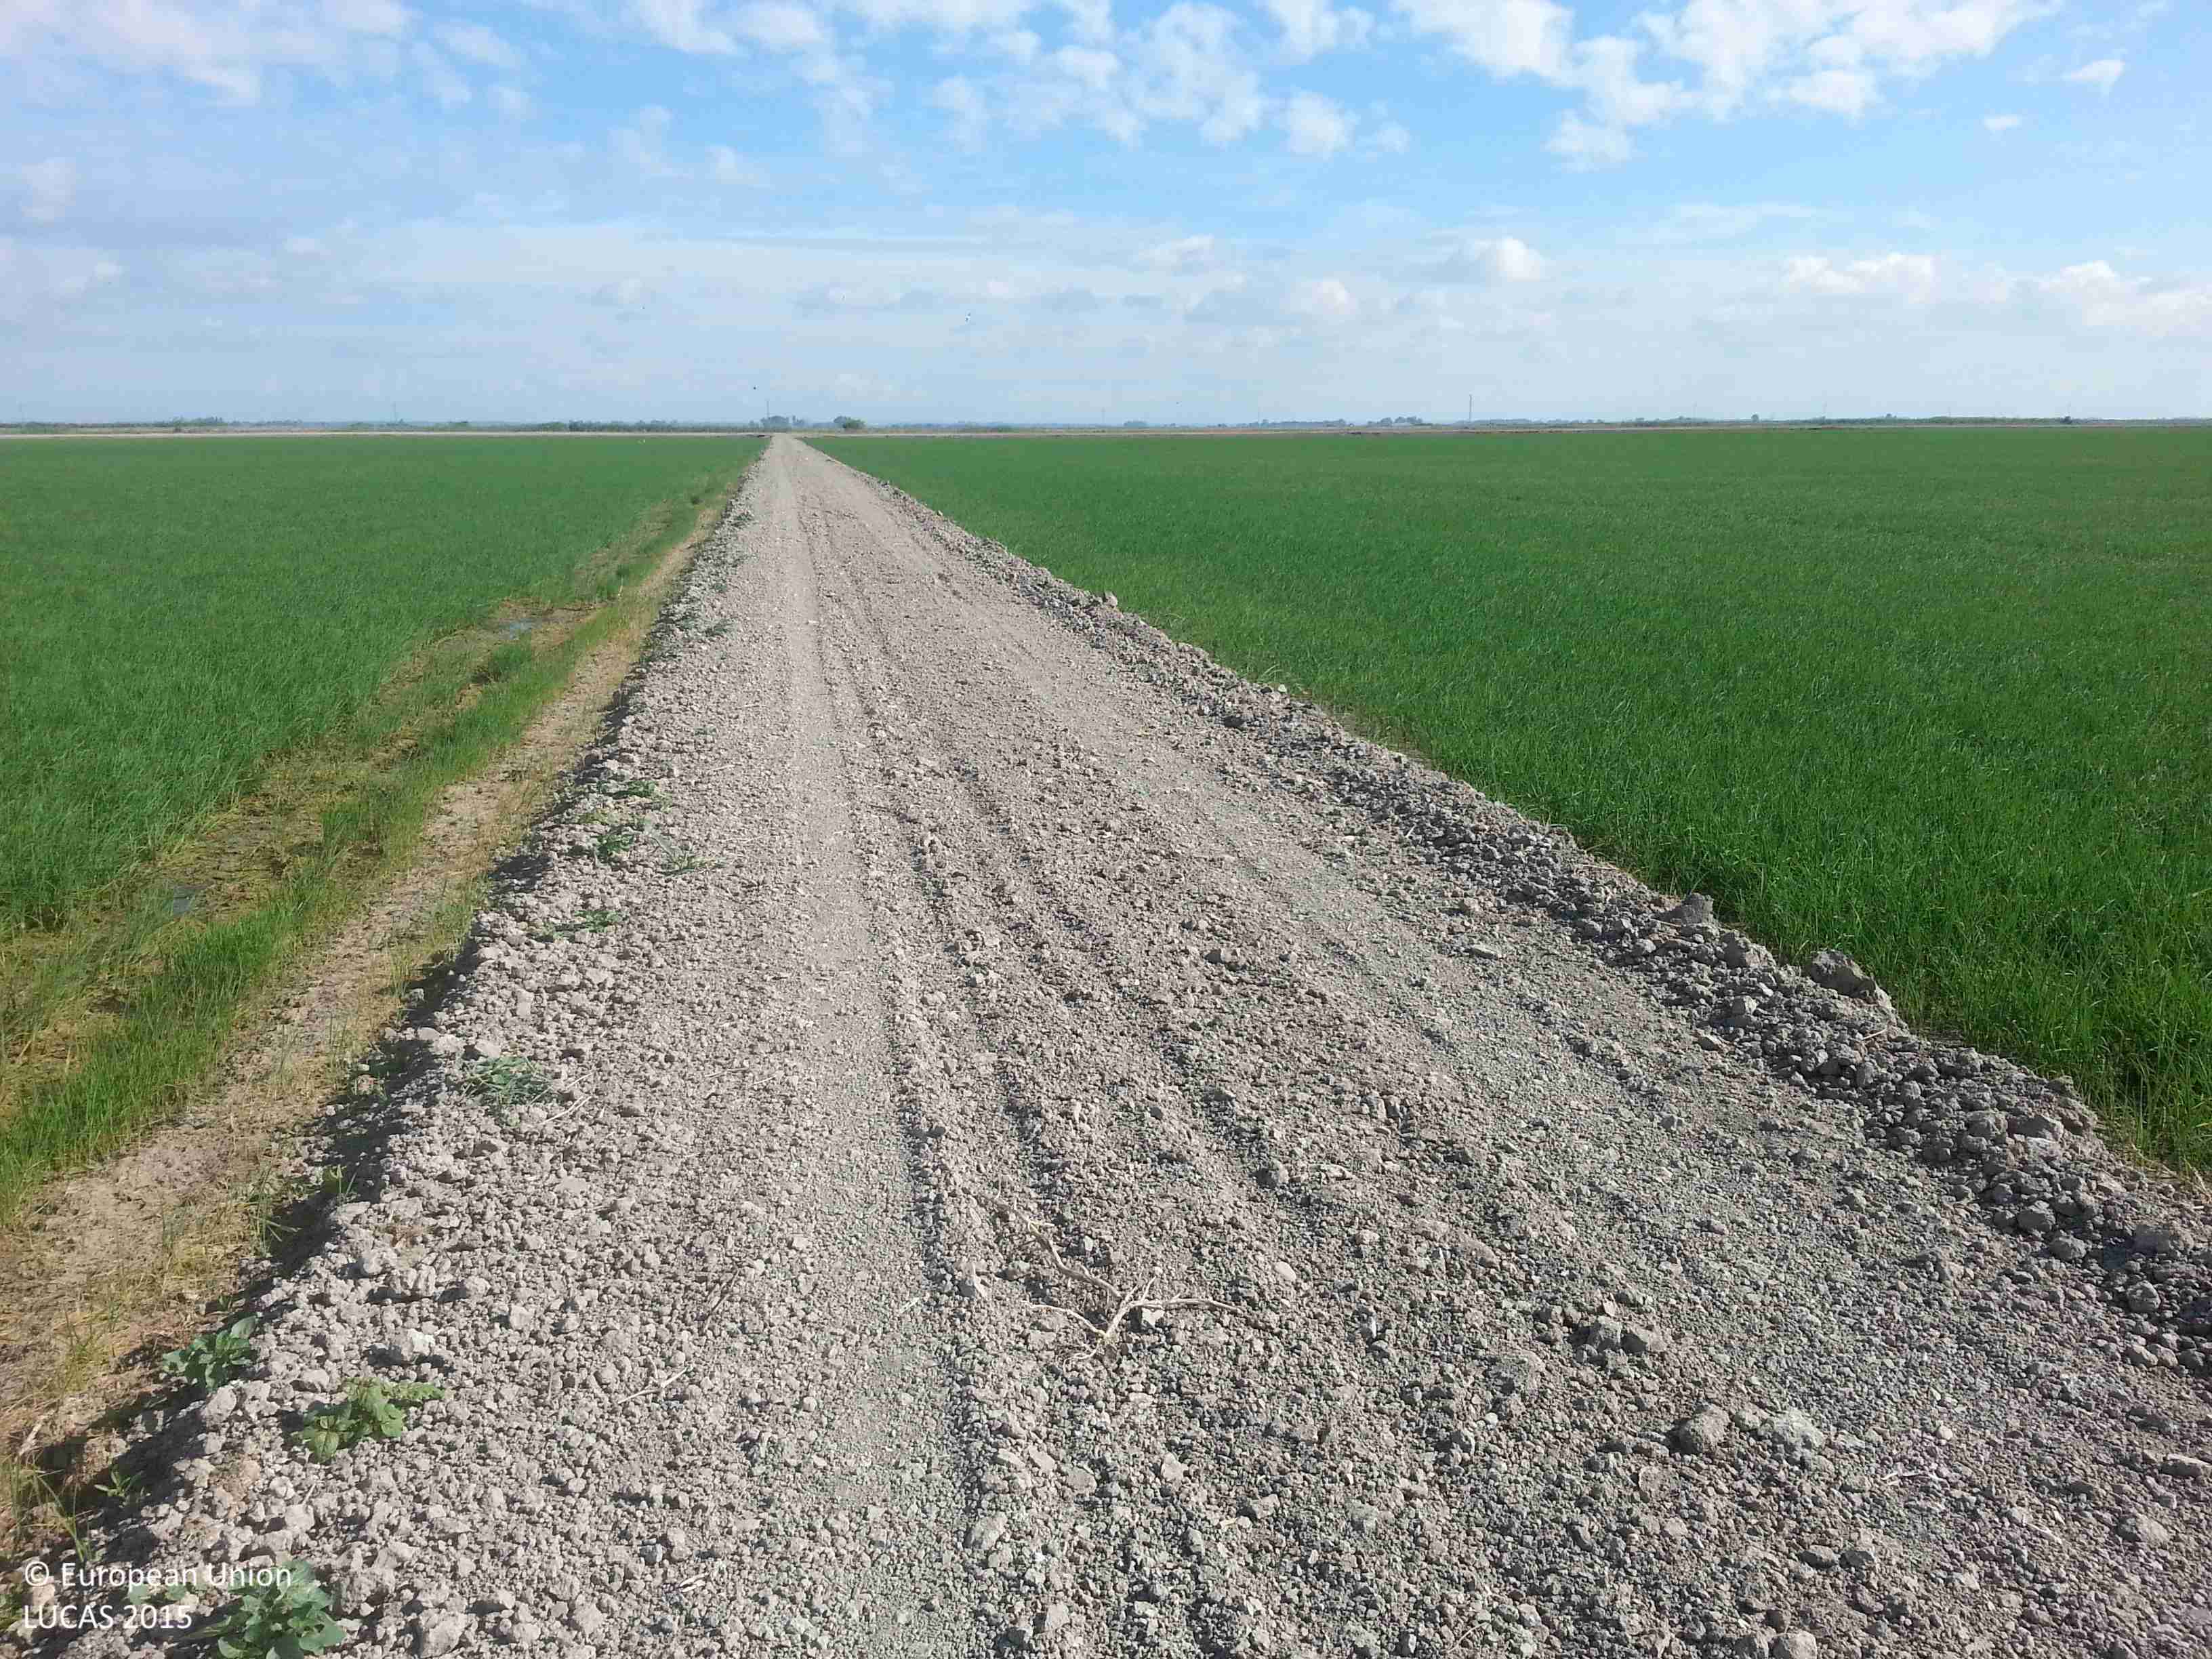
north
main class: Cropland
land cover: Rice
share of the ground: > 75 %
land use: Agriculture (excluding fallow land and kitchen gardens)
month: June
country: ES
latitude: 37.1430
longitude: -6.0859
